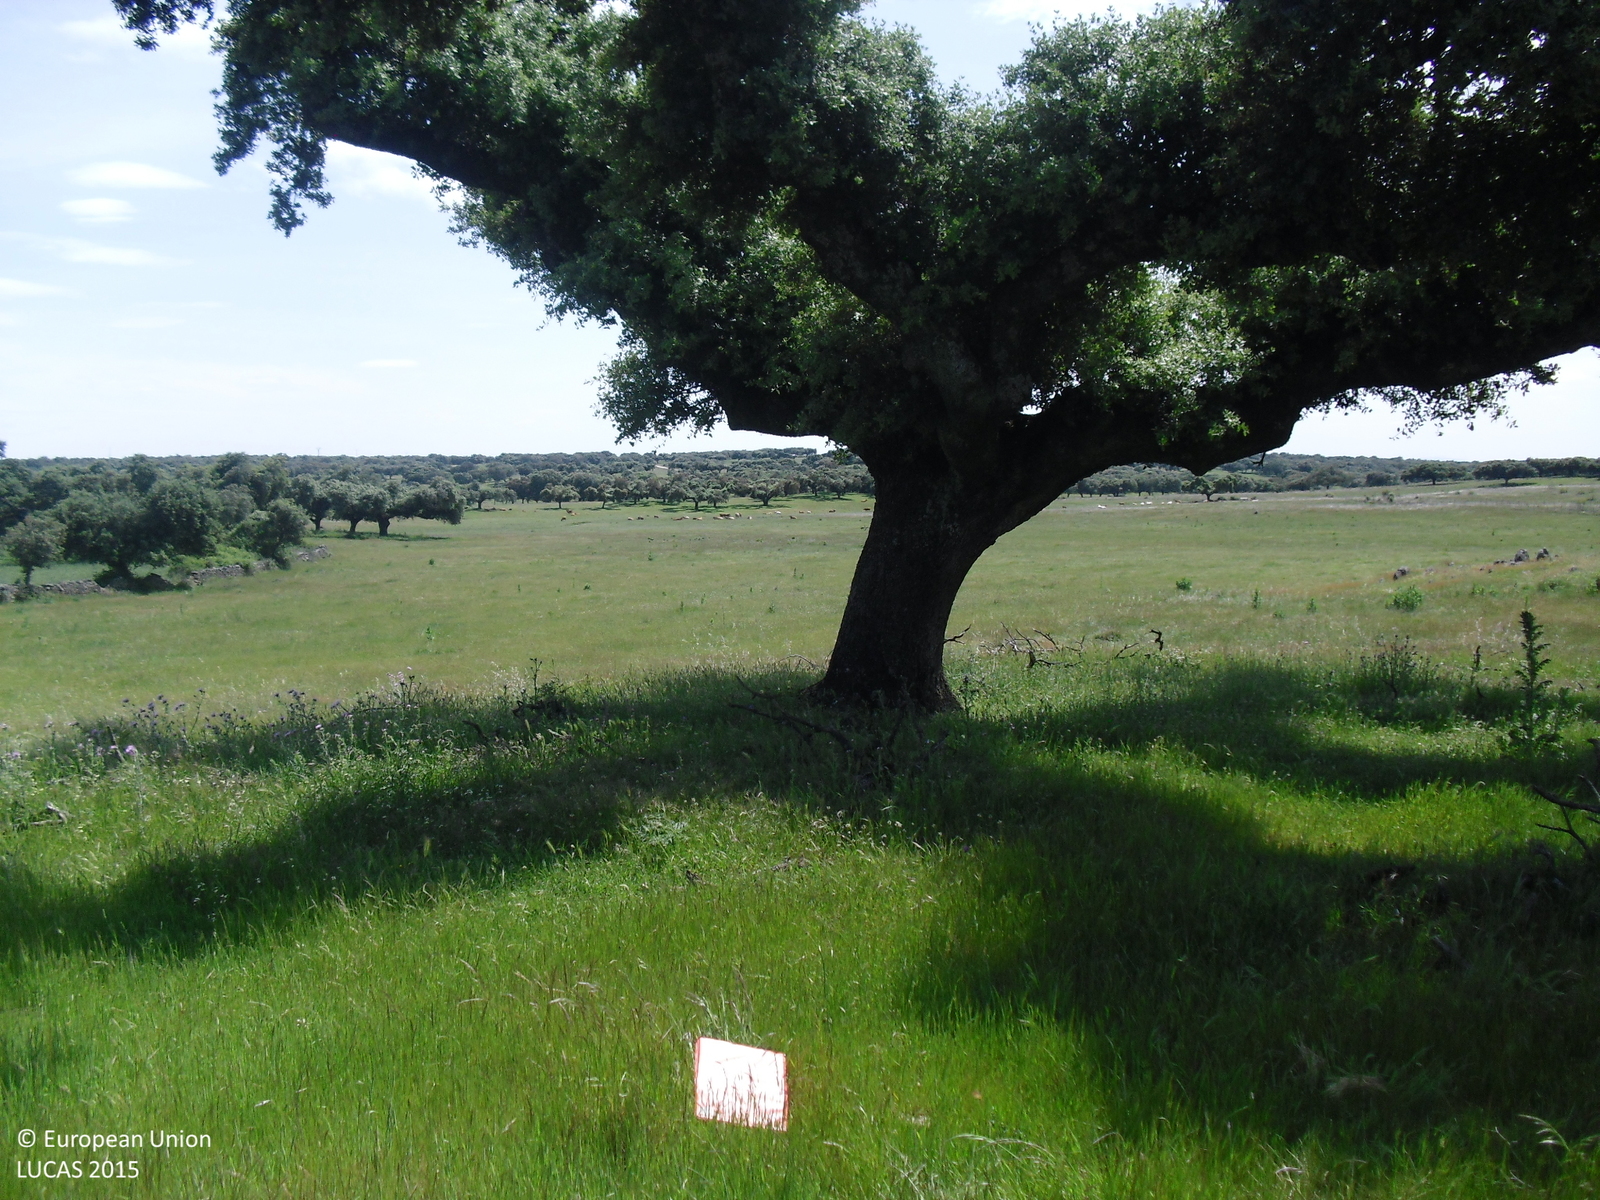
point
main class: Woodland
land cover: Broadleaved woodland
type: broadleaved evergreen forest
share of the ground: 10 - 25 %
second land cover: Grassland without tree/shrub cover
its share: > 75 %
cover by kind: herbaceous plants 85 %, broadleaved forest trees 15 %
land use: Forestry
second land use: Agriculture (excluding fallow land and kitchen gardens)
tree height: > 5 m
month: May
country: ES
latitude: 39.3232
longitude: -5.4880
